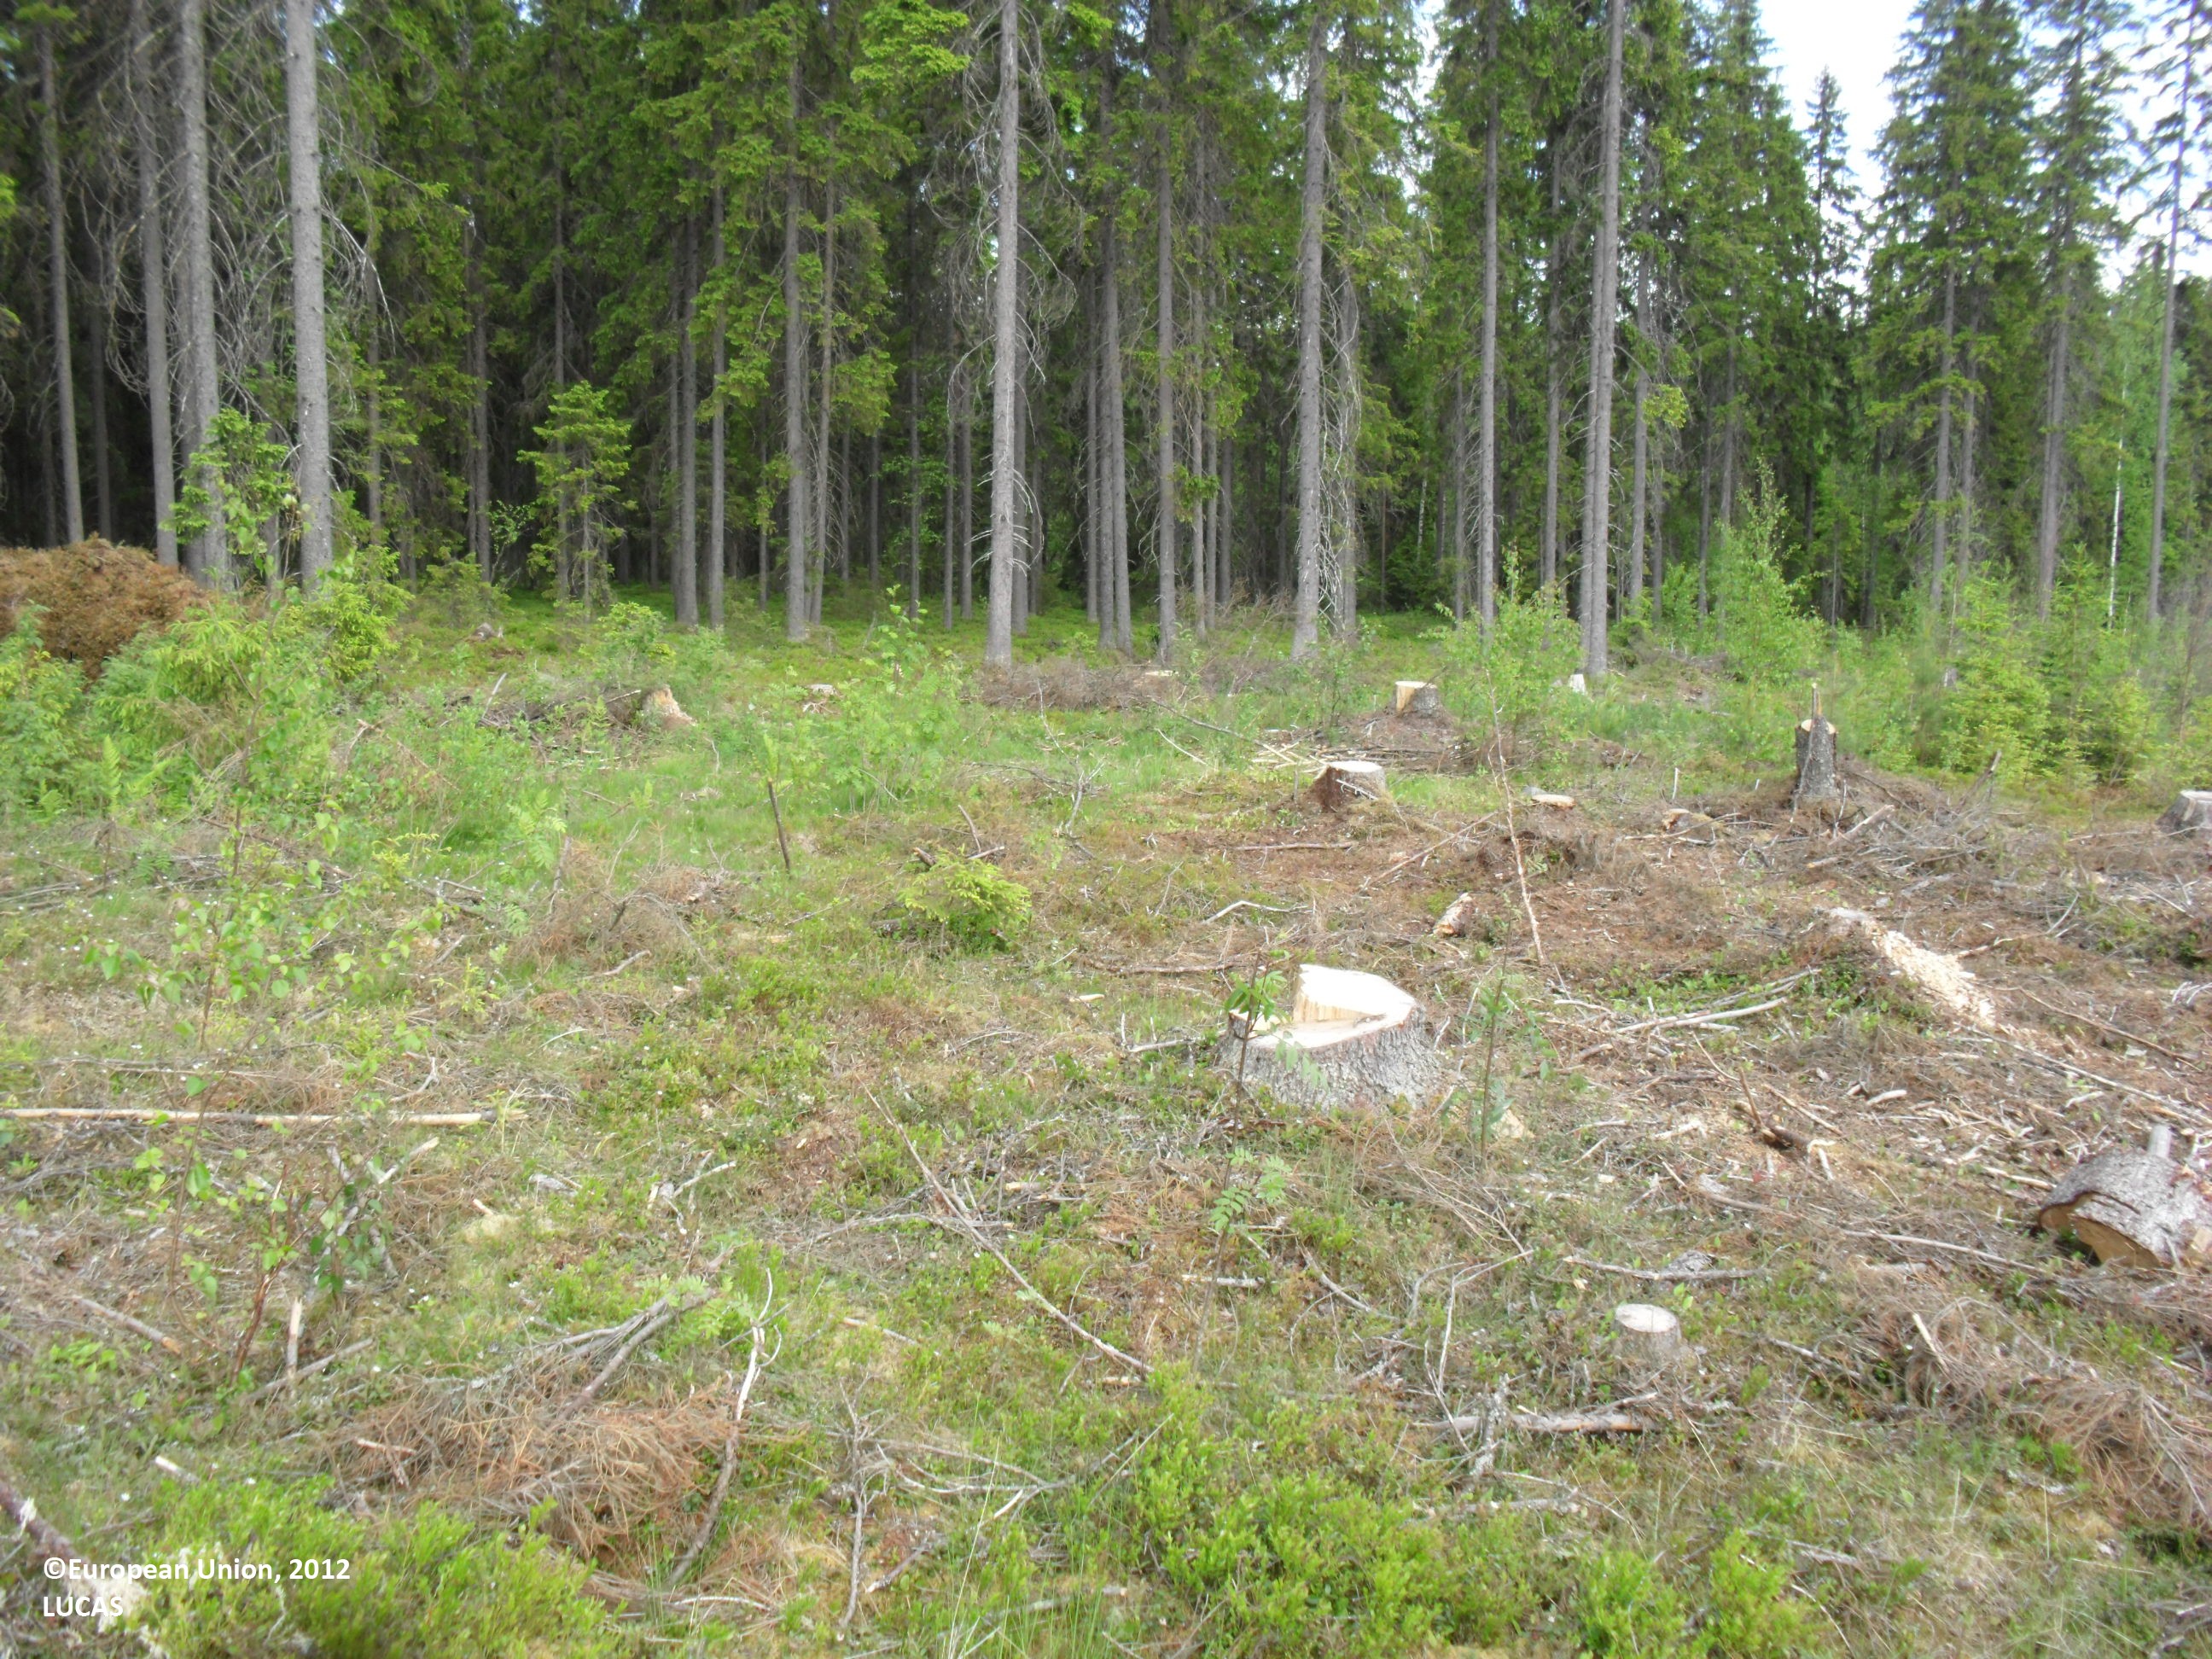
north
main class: Grassland
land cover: Grassland with sparse tree/shrub cover
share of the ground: < 10 %
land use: Forestry
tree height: < 5 m
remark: Clear cut
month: June
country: FI
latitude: 62.7934
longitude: 23.4582
